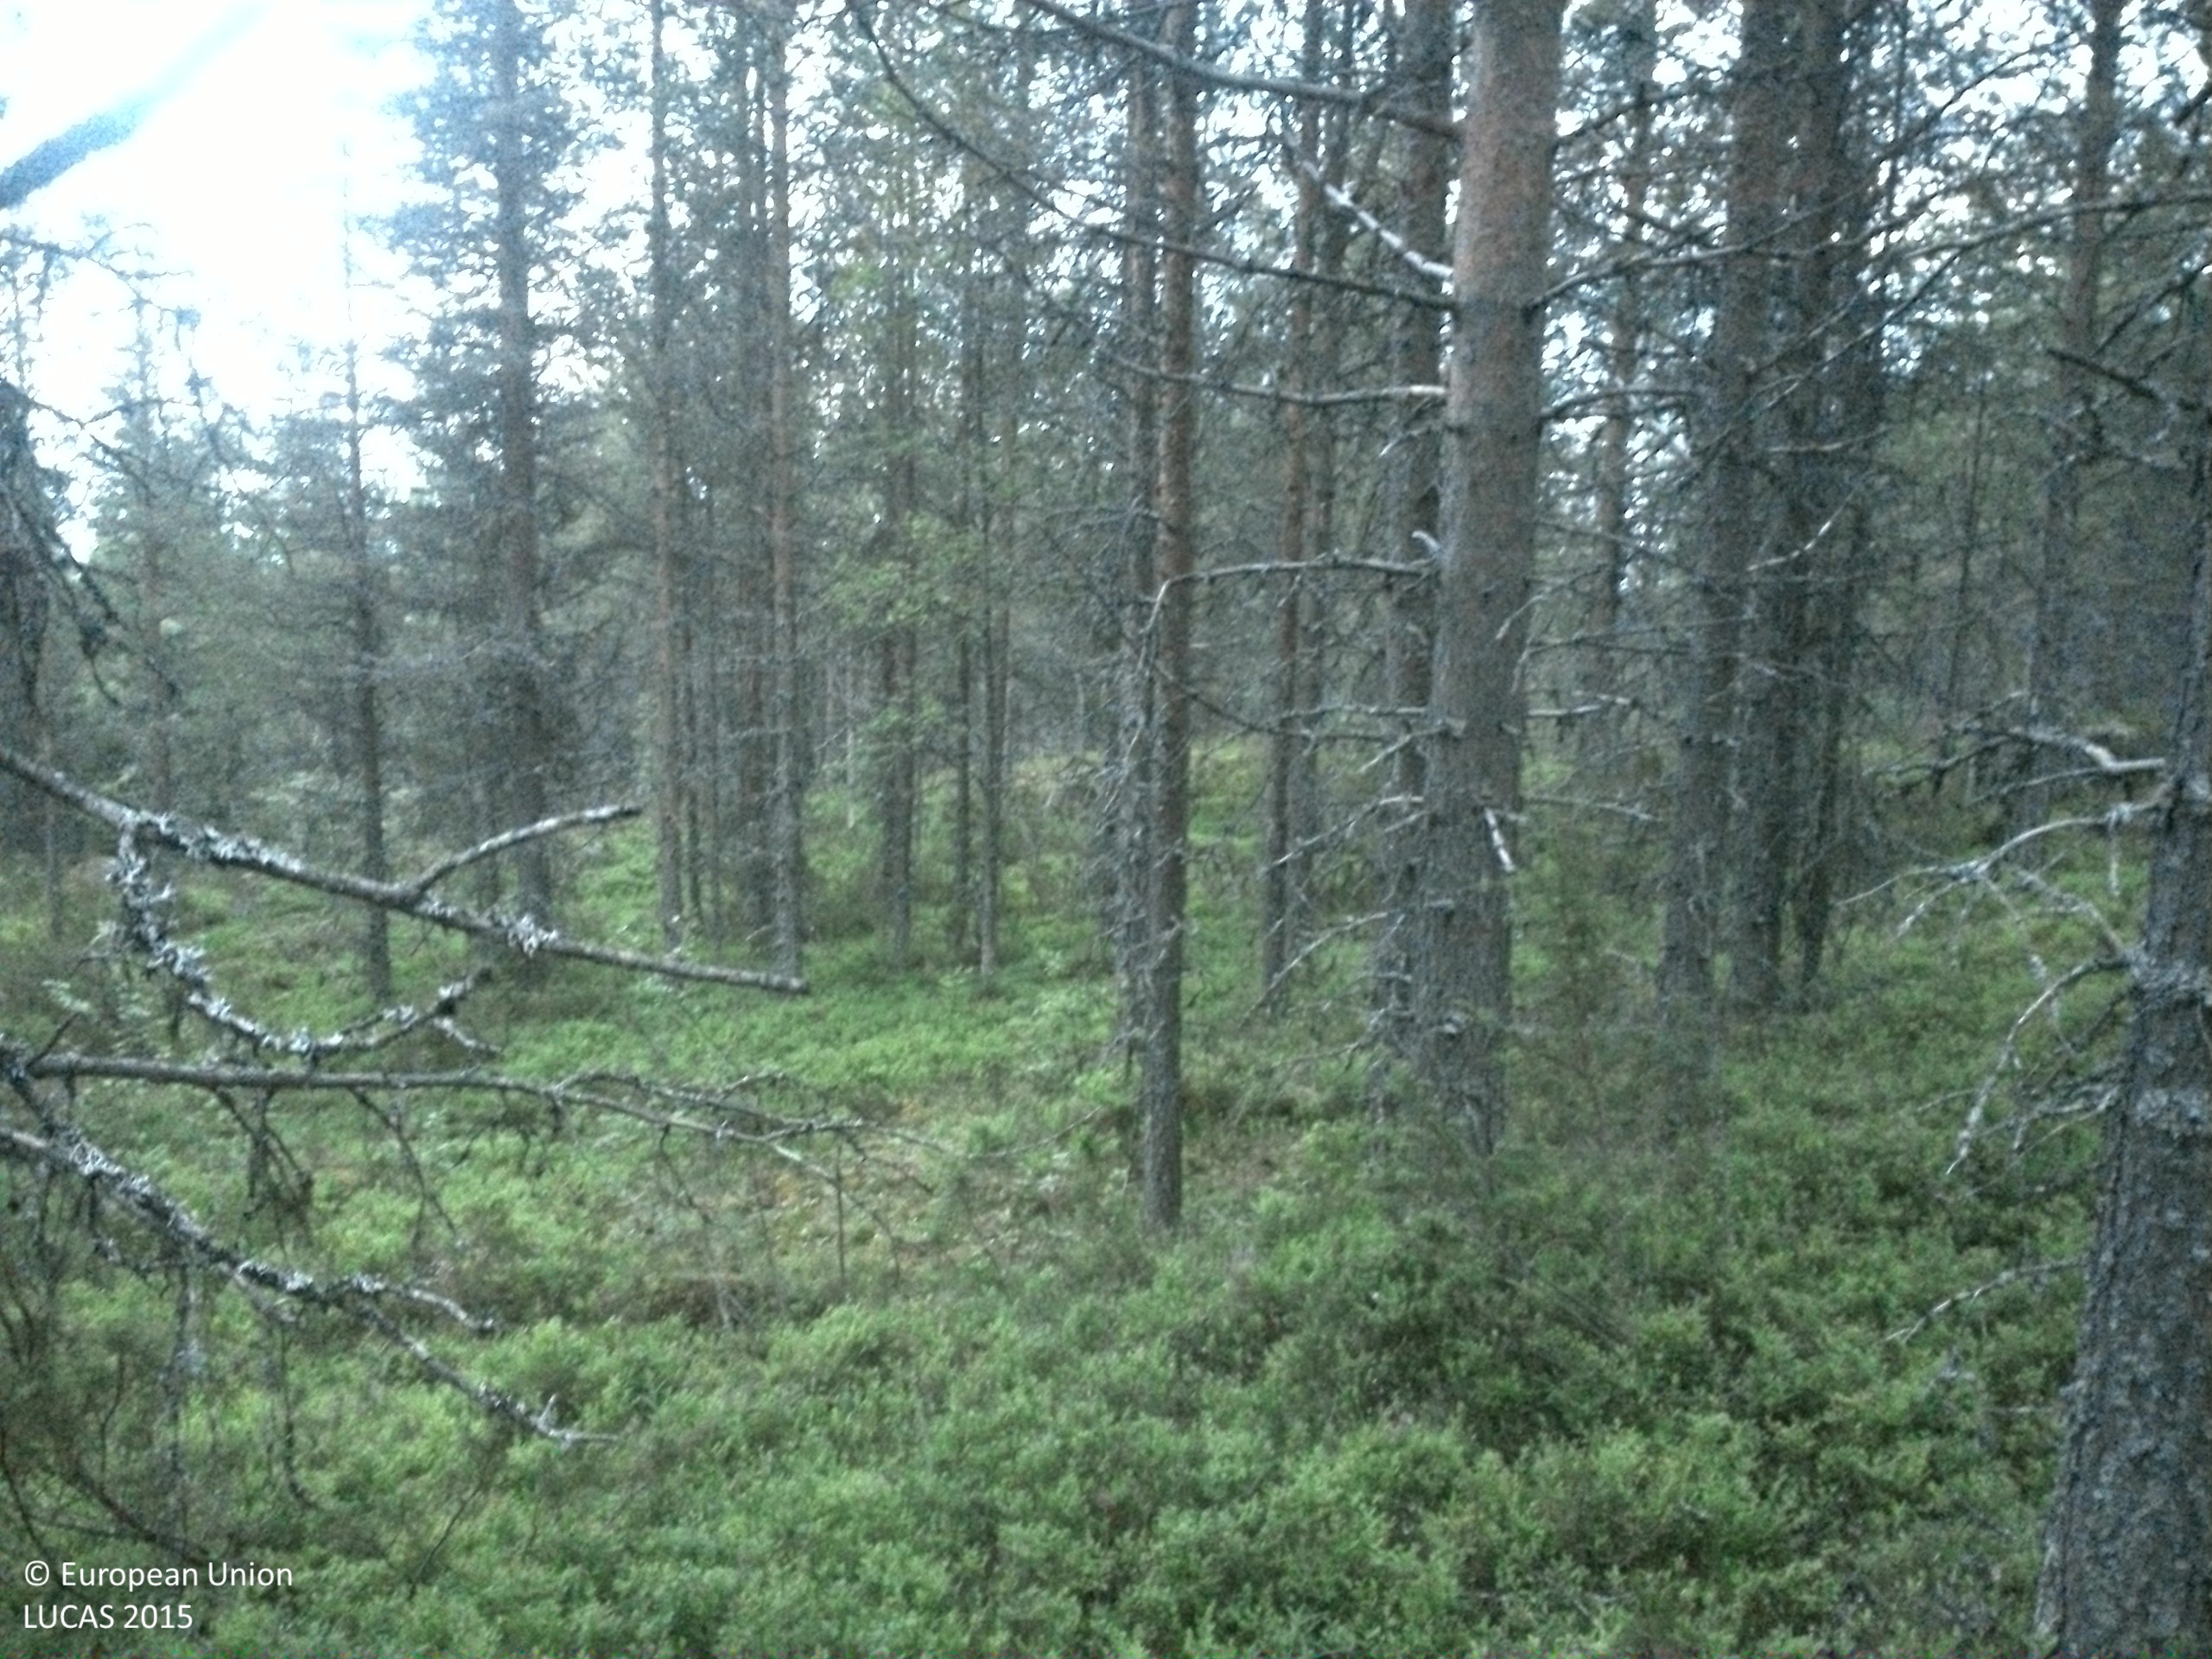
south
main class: Woodland
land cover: Pine dominated coniferous woodland
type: boreal forest
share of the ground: 50 - 75 %
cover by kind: coniferous forest trees 55 %, shrubs 35 %, broadleaved forest trees 5 %, herbaceous plants 5 %
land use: Forestry
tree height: > 5 m
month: July
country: SE
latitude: 64.2252
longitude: 16.5858
